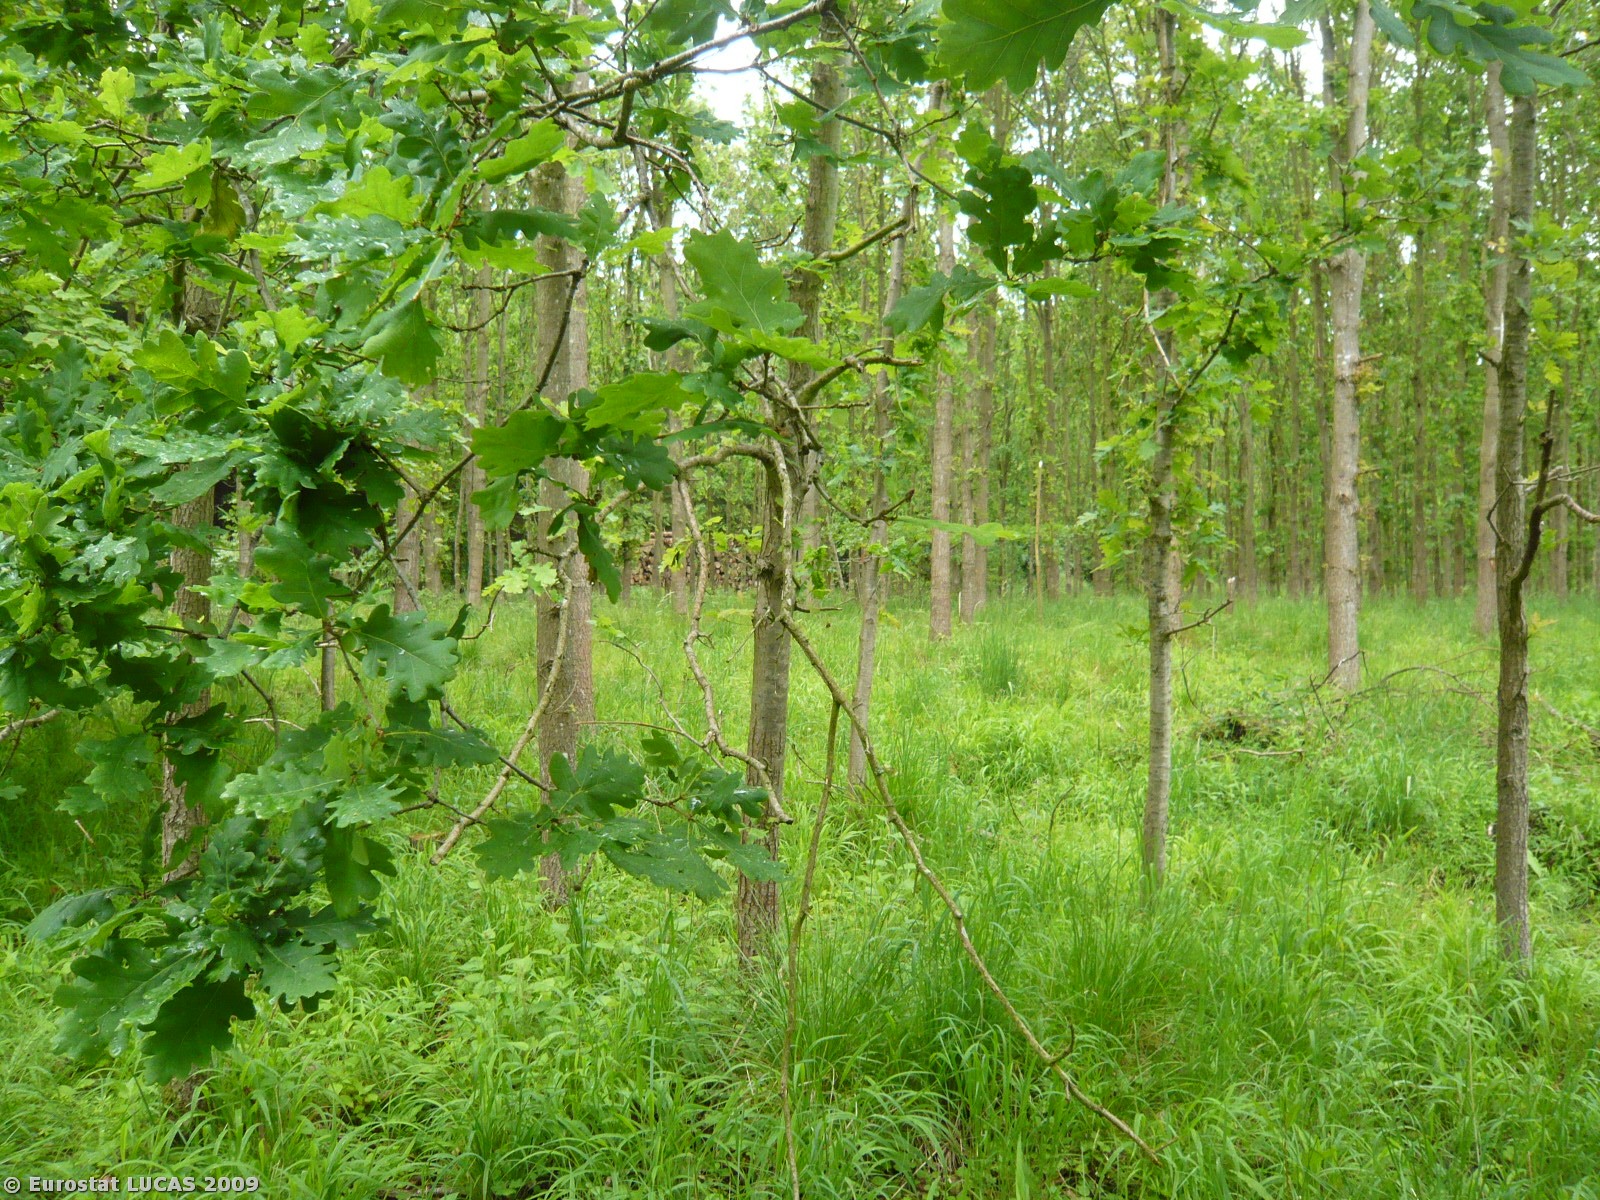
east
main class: Woodland
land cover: Broadleaved woodland
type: plantations and self-sown exotic forest
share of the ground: > 75 %
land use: Forestry
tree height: > 5 m
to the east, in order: Broadleaved woodland; Tracks; Coniferous woodland; Broadleaved woodland; Ditches and canals; Broadleaved woodland
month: June
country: DK
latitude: 54.7532
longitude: 11.9100
